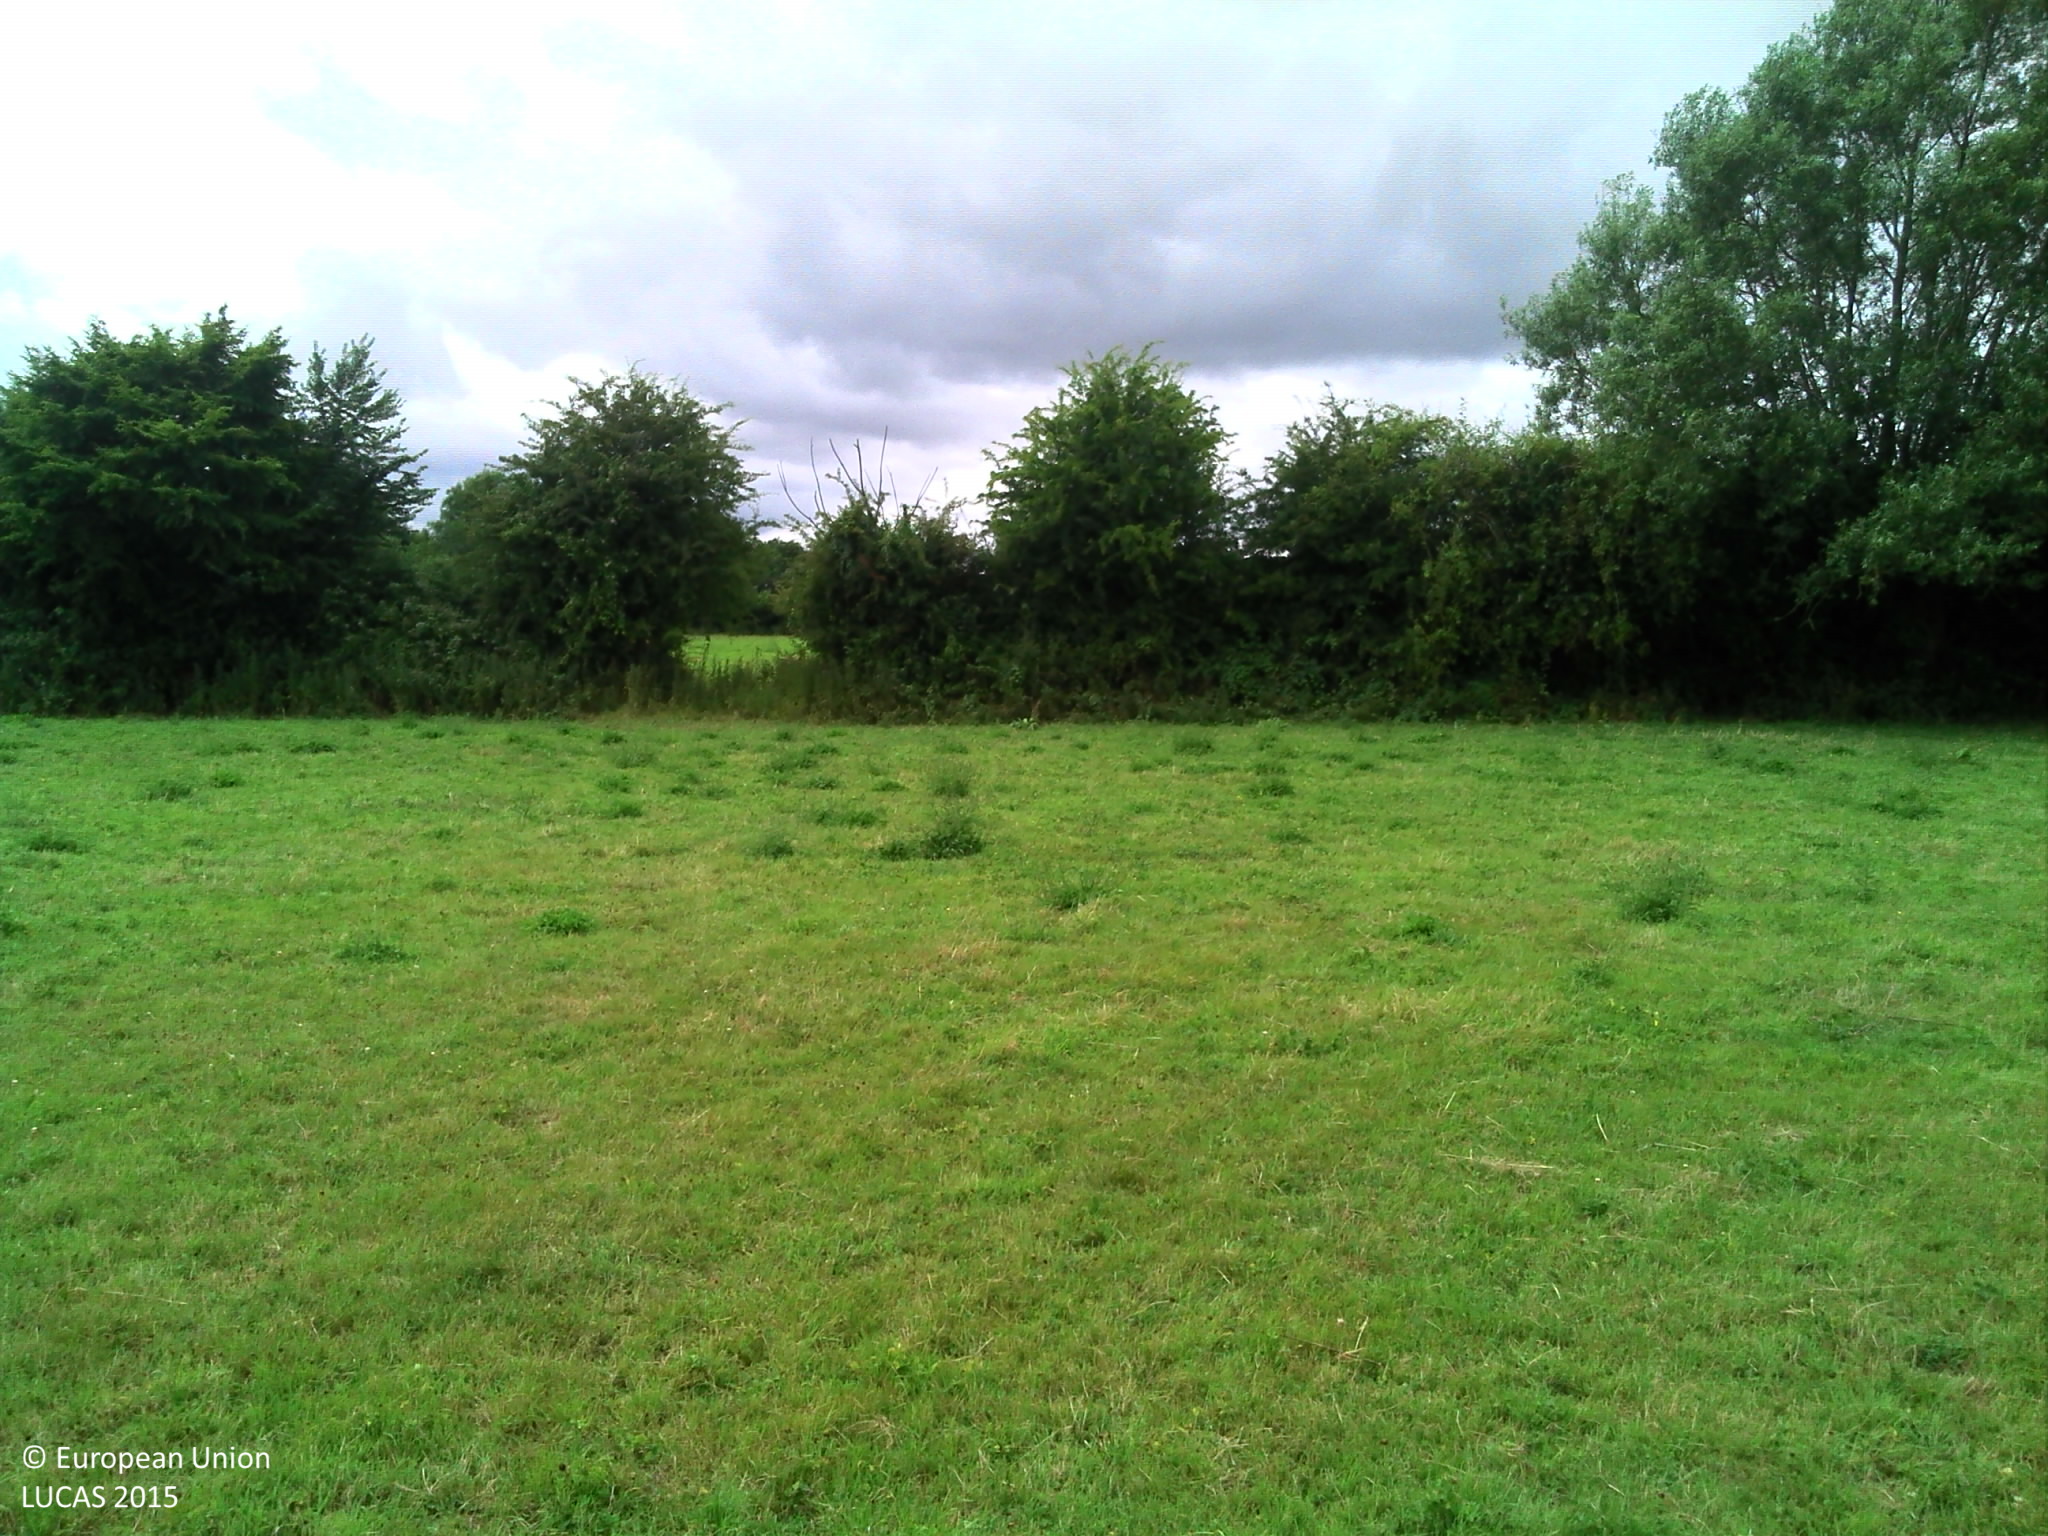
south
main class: Grassland
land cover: Grassland without tree/shrub cover
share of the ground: > 75 %
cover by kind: herbaceous plants 100 %
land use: Agriculture (excluding fallow land and kitchen gardens)
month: July
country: FR
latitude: 48.8608
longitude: 0.4734
